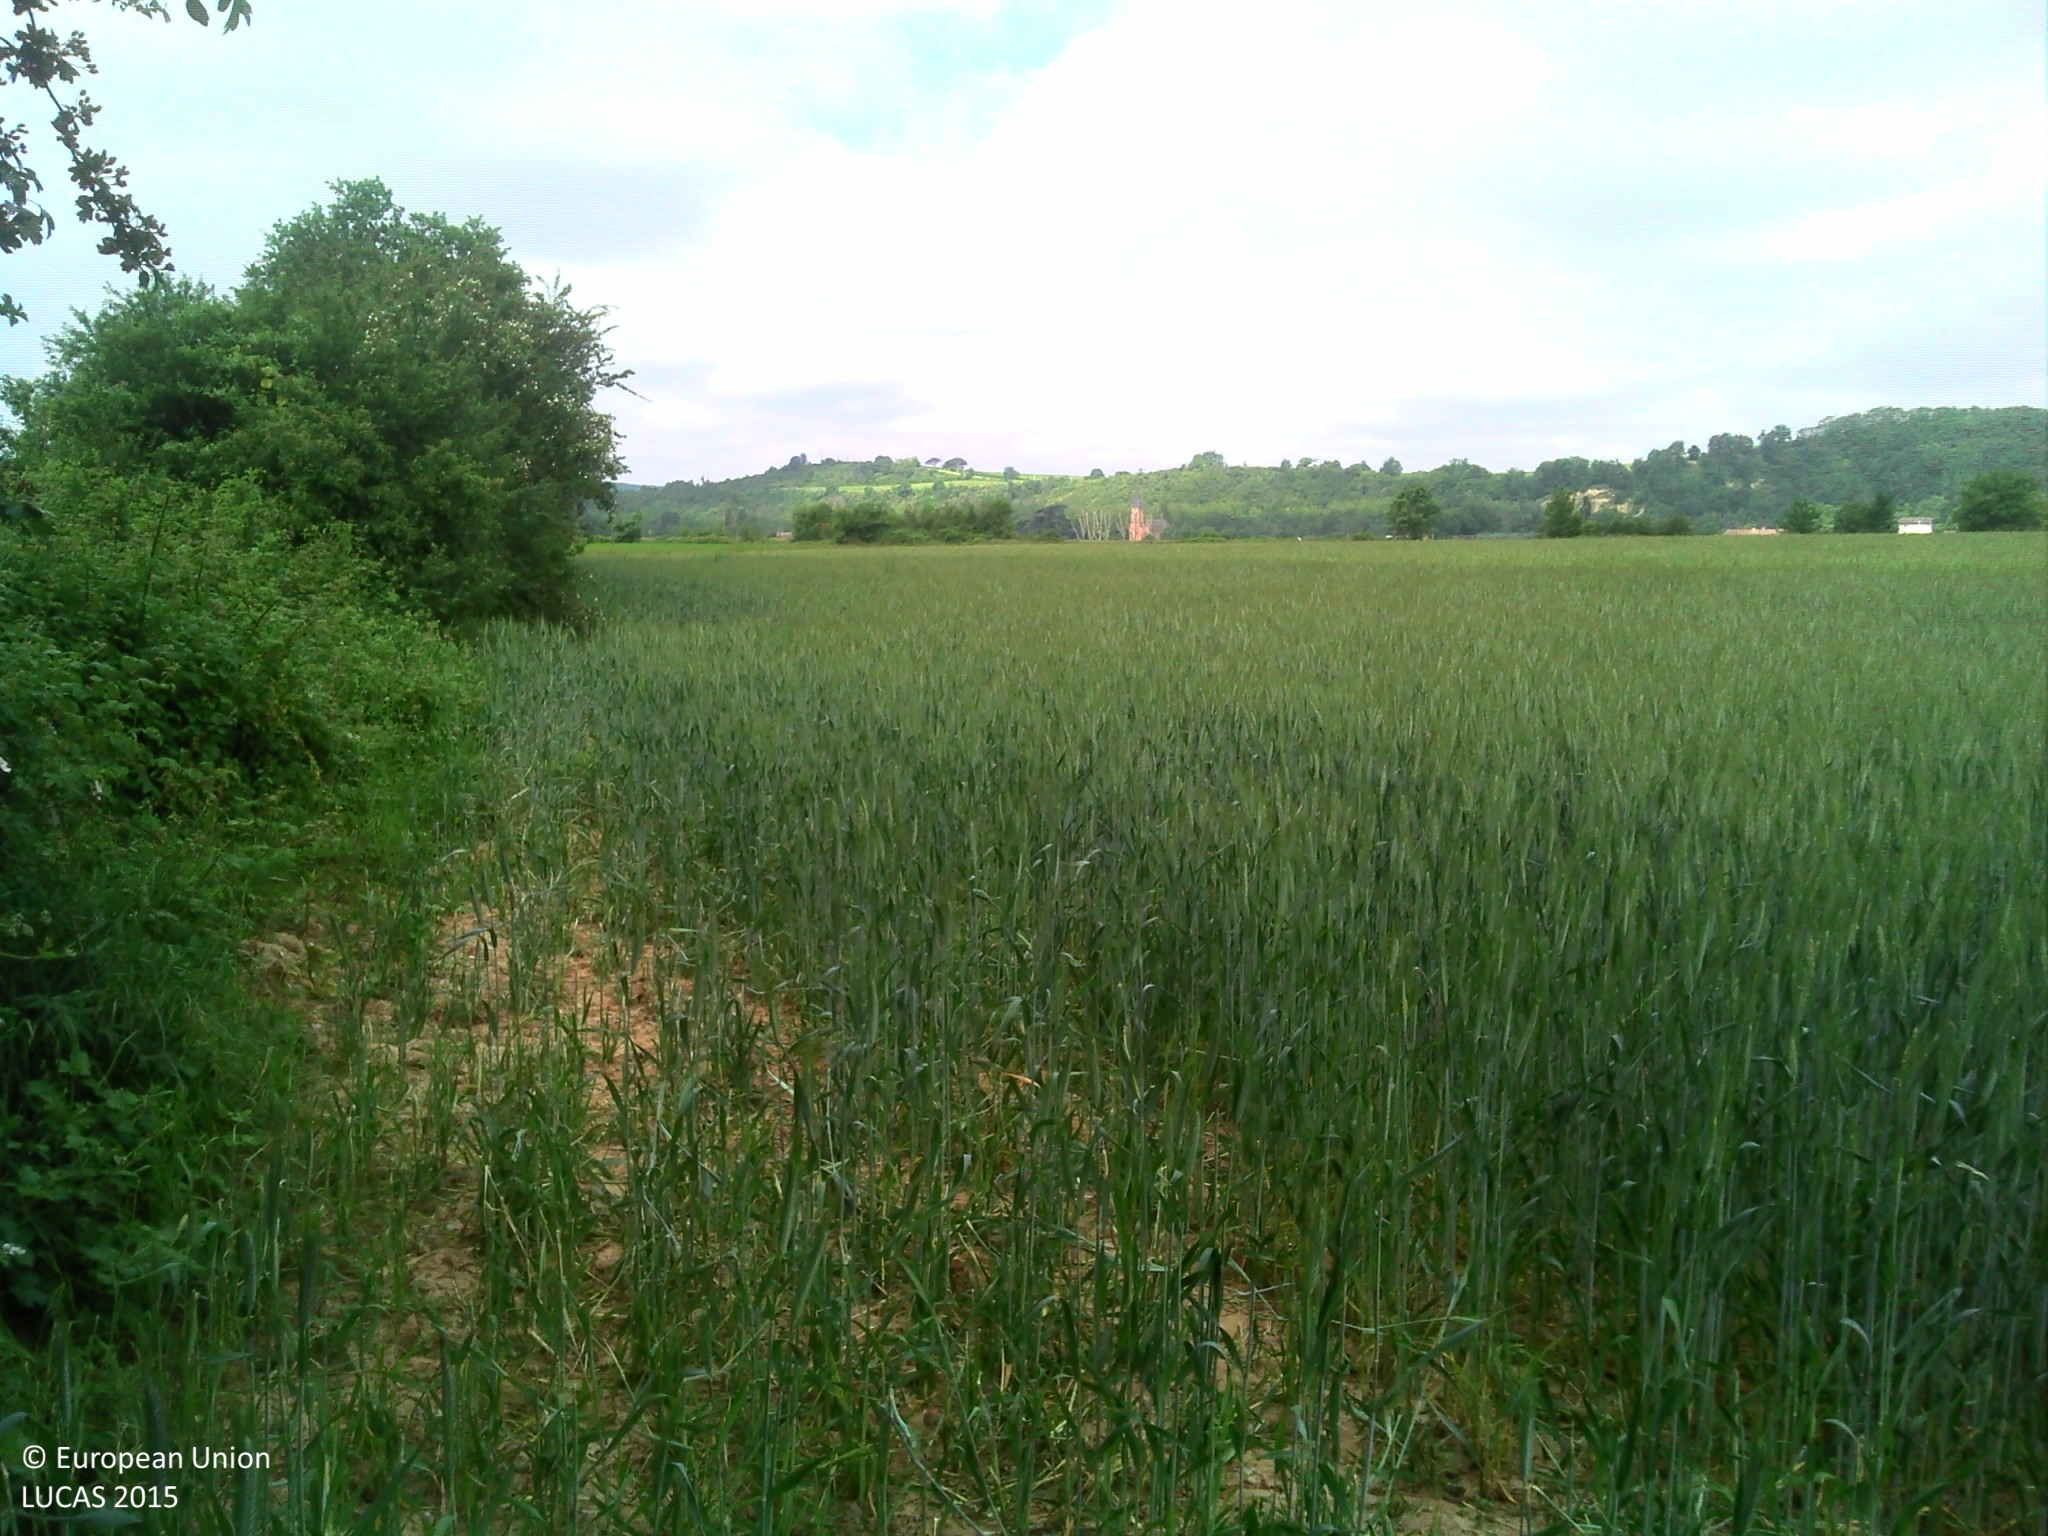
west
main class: Cropland
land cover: Triticale
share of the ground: > 75 %
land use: Agriculture (excluding fallow land and kitchen gardens)
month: May
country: FR
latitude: 43.8011
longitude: 1.7123
